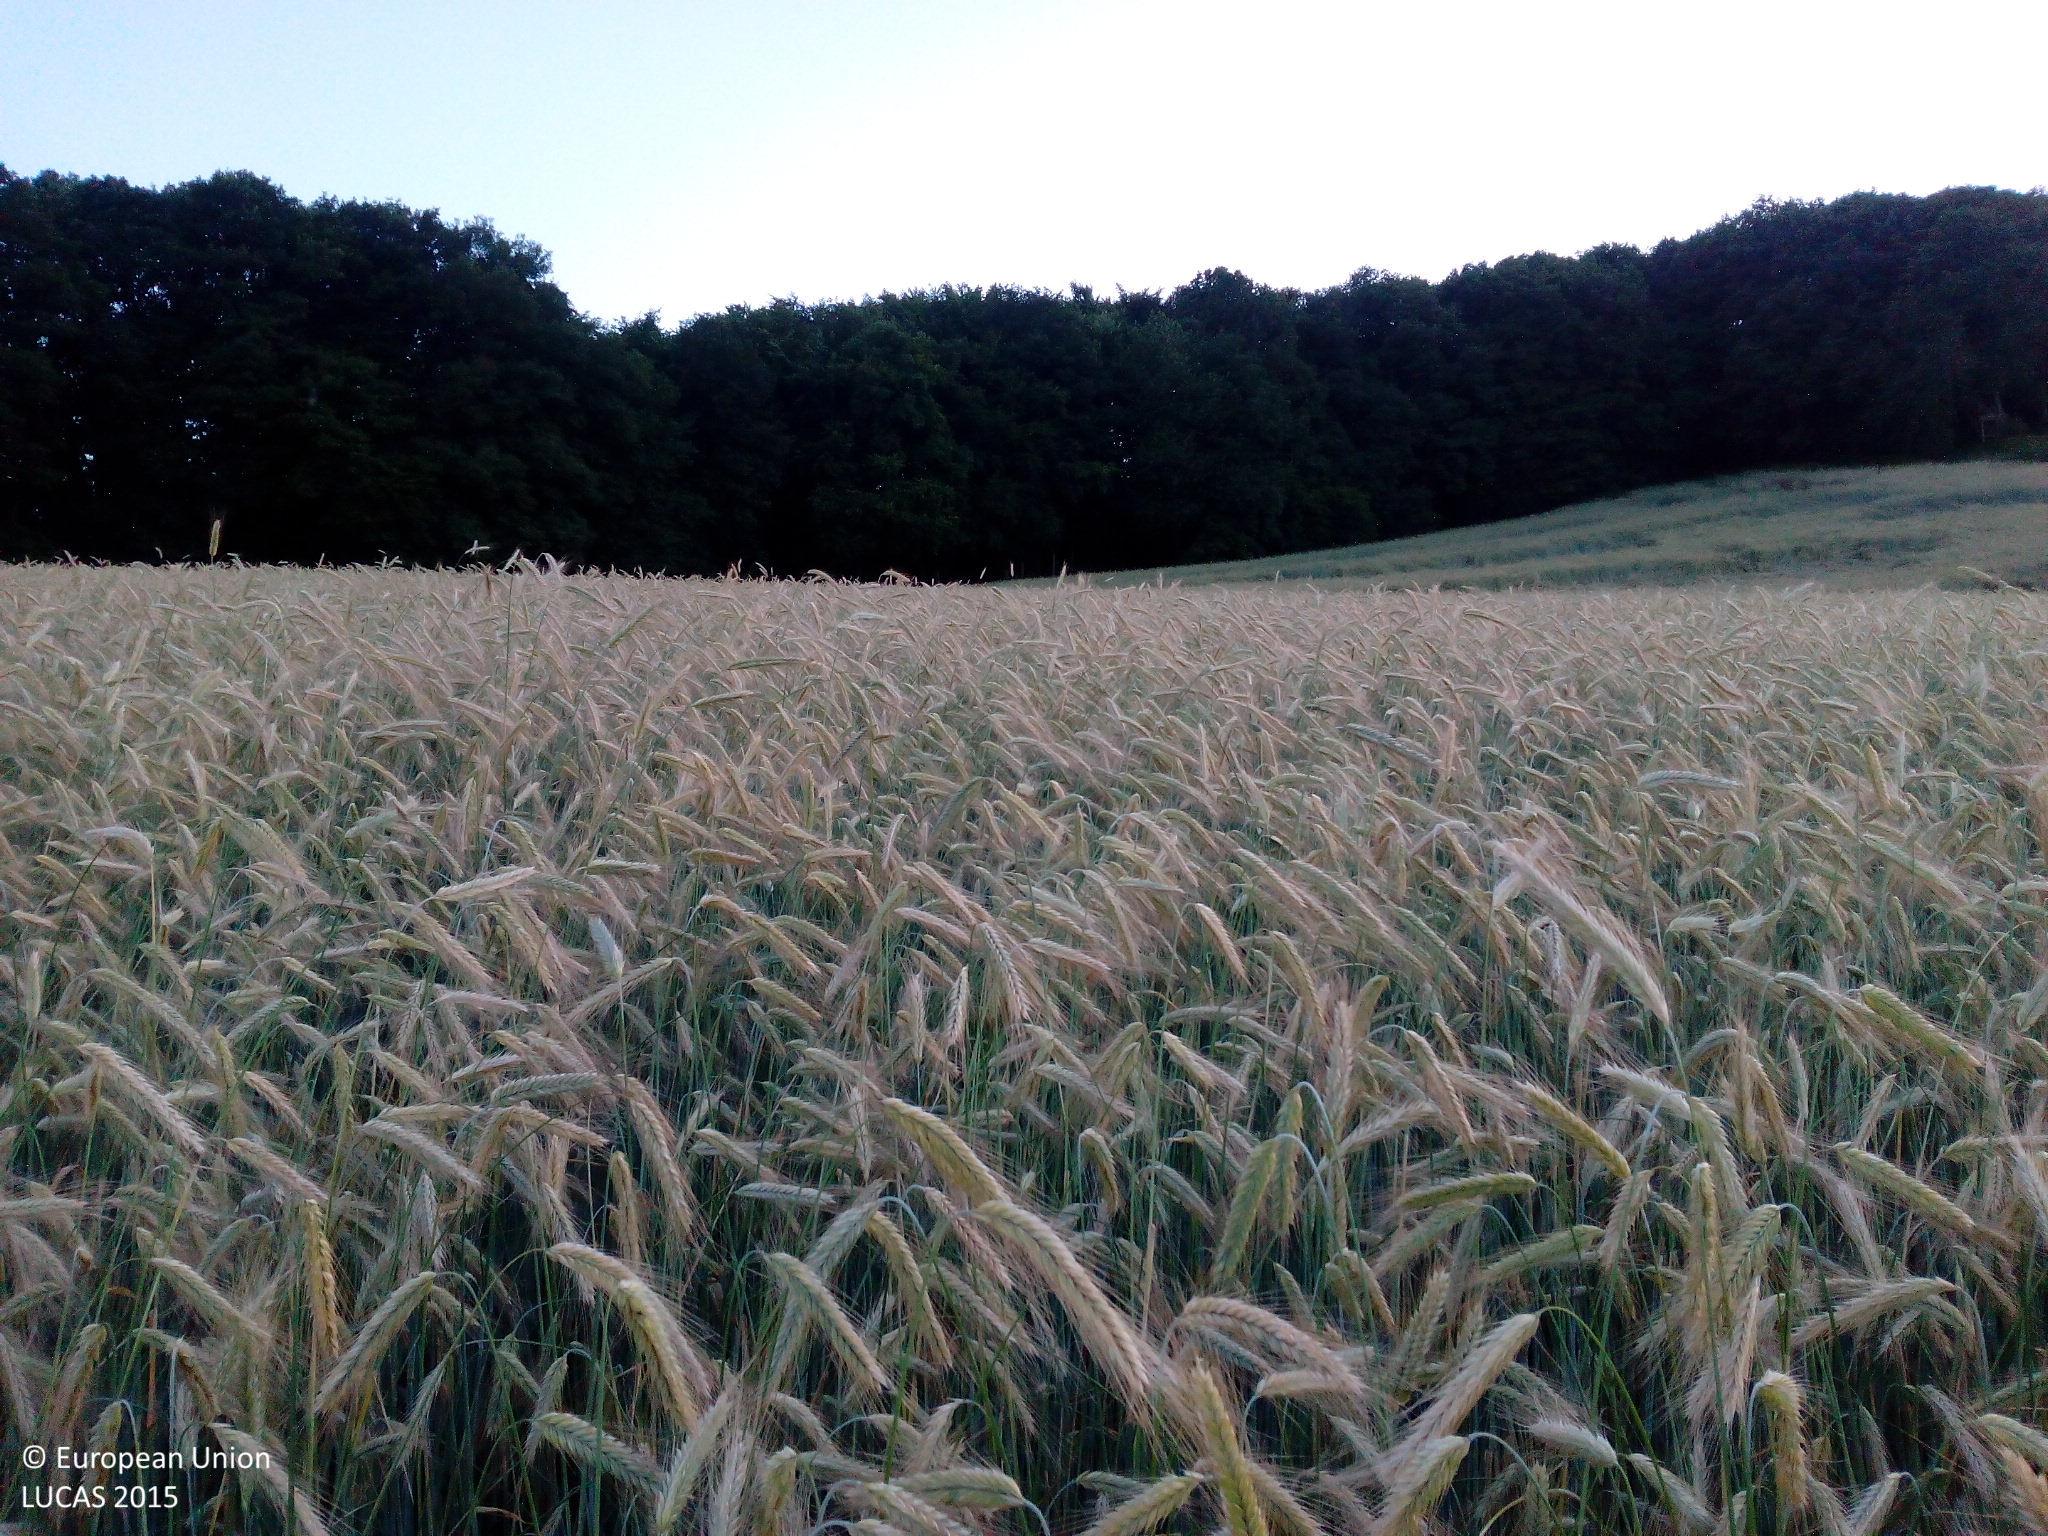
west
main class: Cropland
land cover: Barley
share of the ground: > 75 %
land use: Agriculture (excluding fallow land and kitchen gardens)
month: June
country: DE
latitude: 49.4918
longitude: 7.5292
